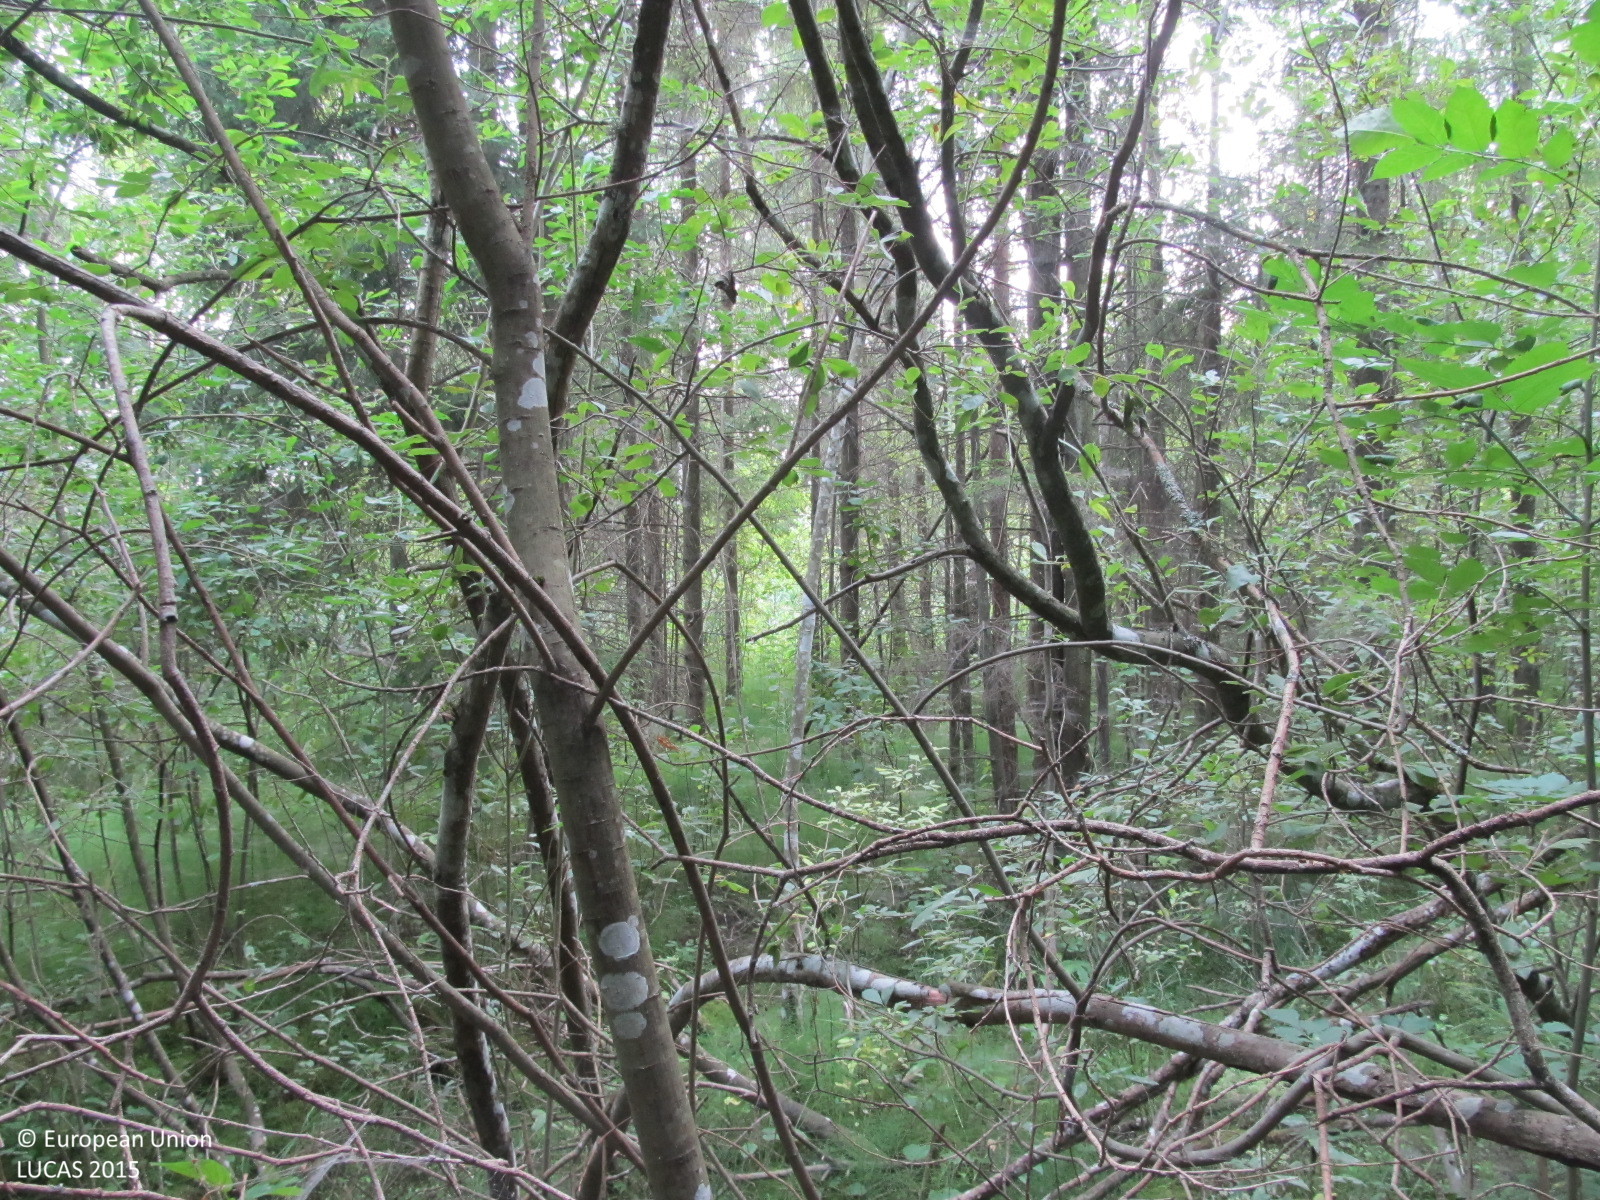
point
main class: Woodland
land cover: Other mixed woodland
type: hemiboreal forest and nemoral coniferous forest and mixed broadleaved-coniferous forest
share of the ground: > 75 %
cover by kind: coniferous forest trees 50 %, broadleaved forest trees 30 %, herbaceous plants 15 %, shrubs 5 %
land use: Forestry
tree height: > 5 m
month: August
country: LT
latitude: 55.8566
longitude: 23.1226
